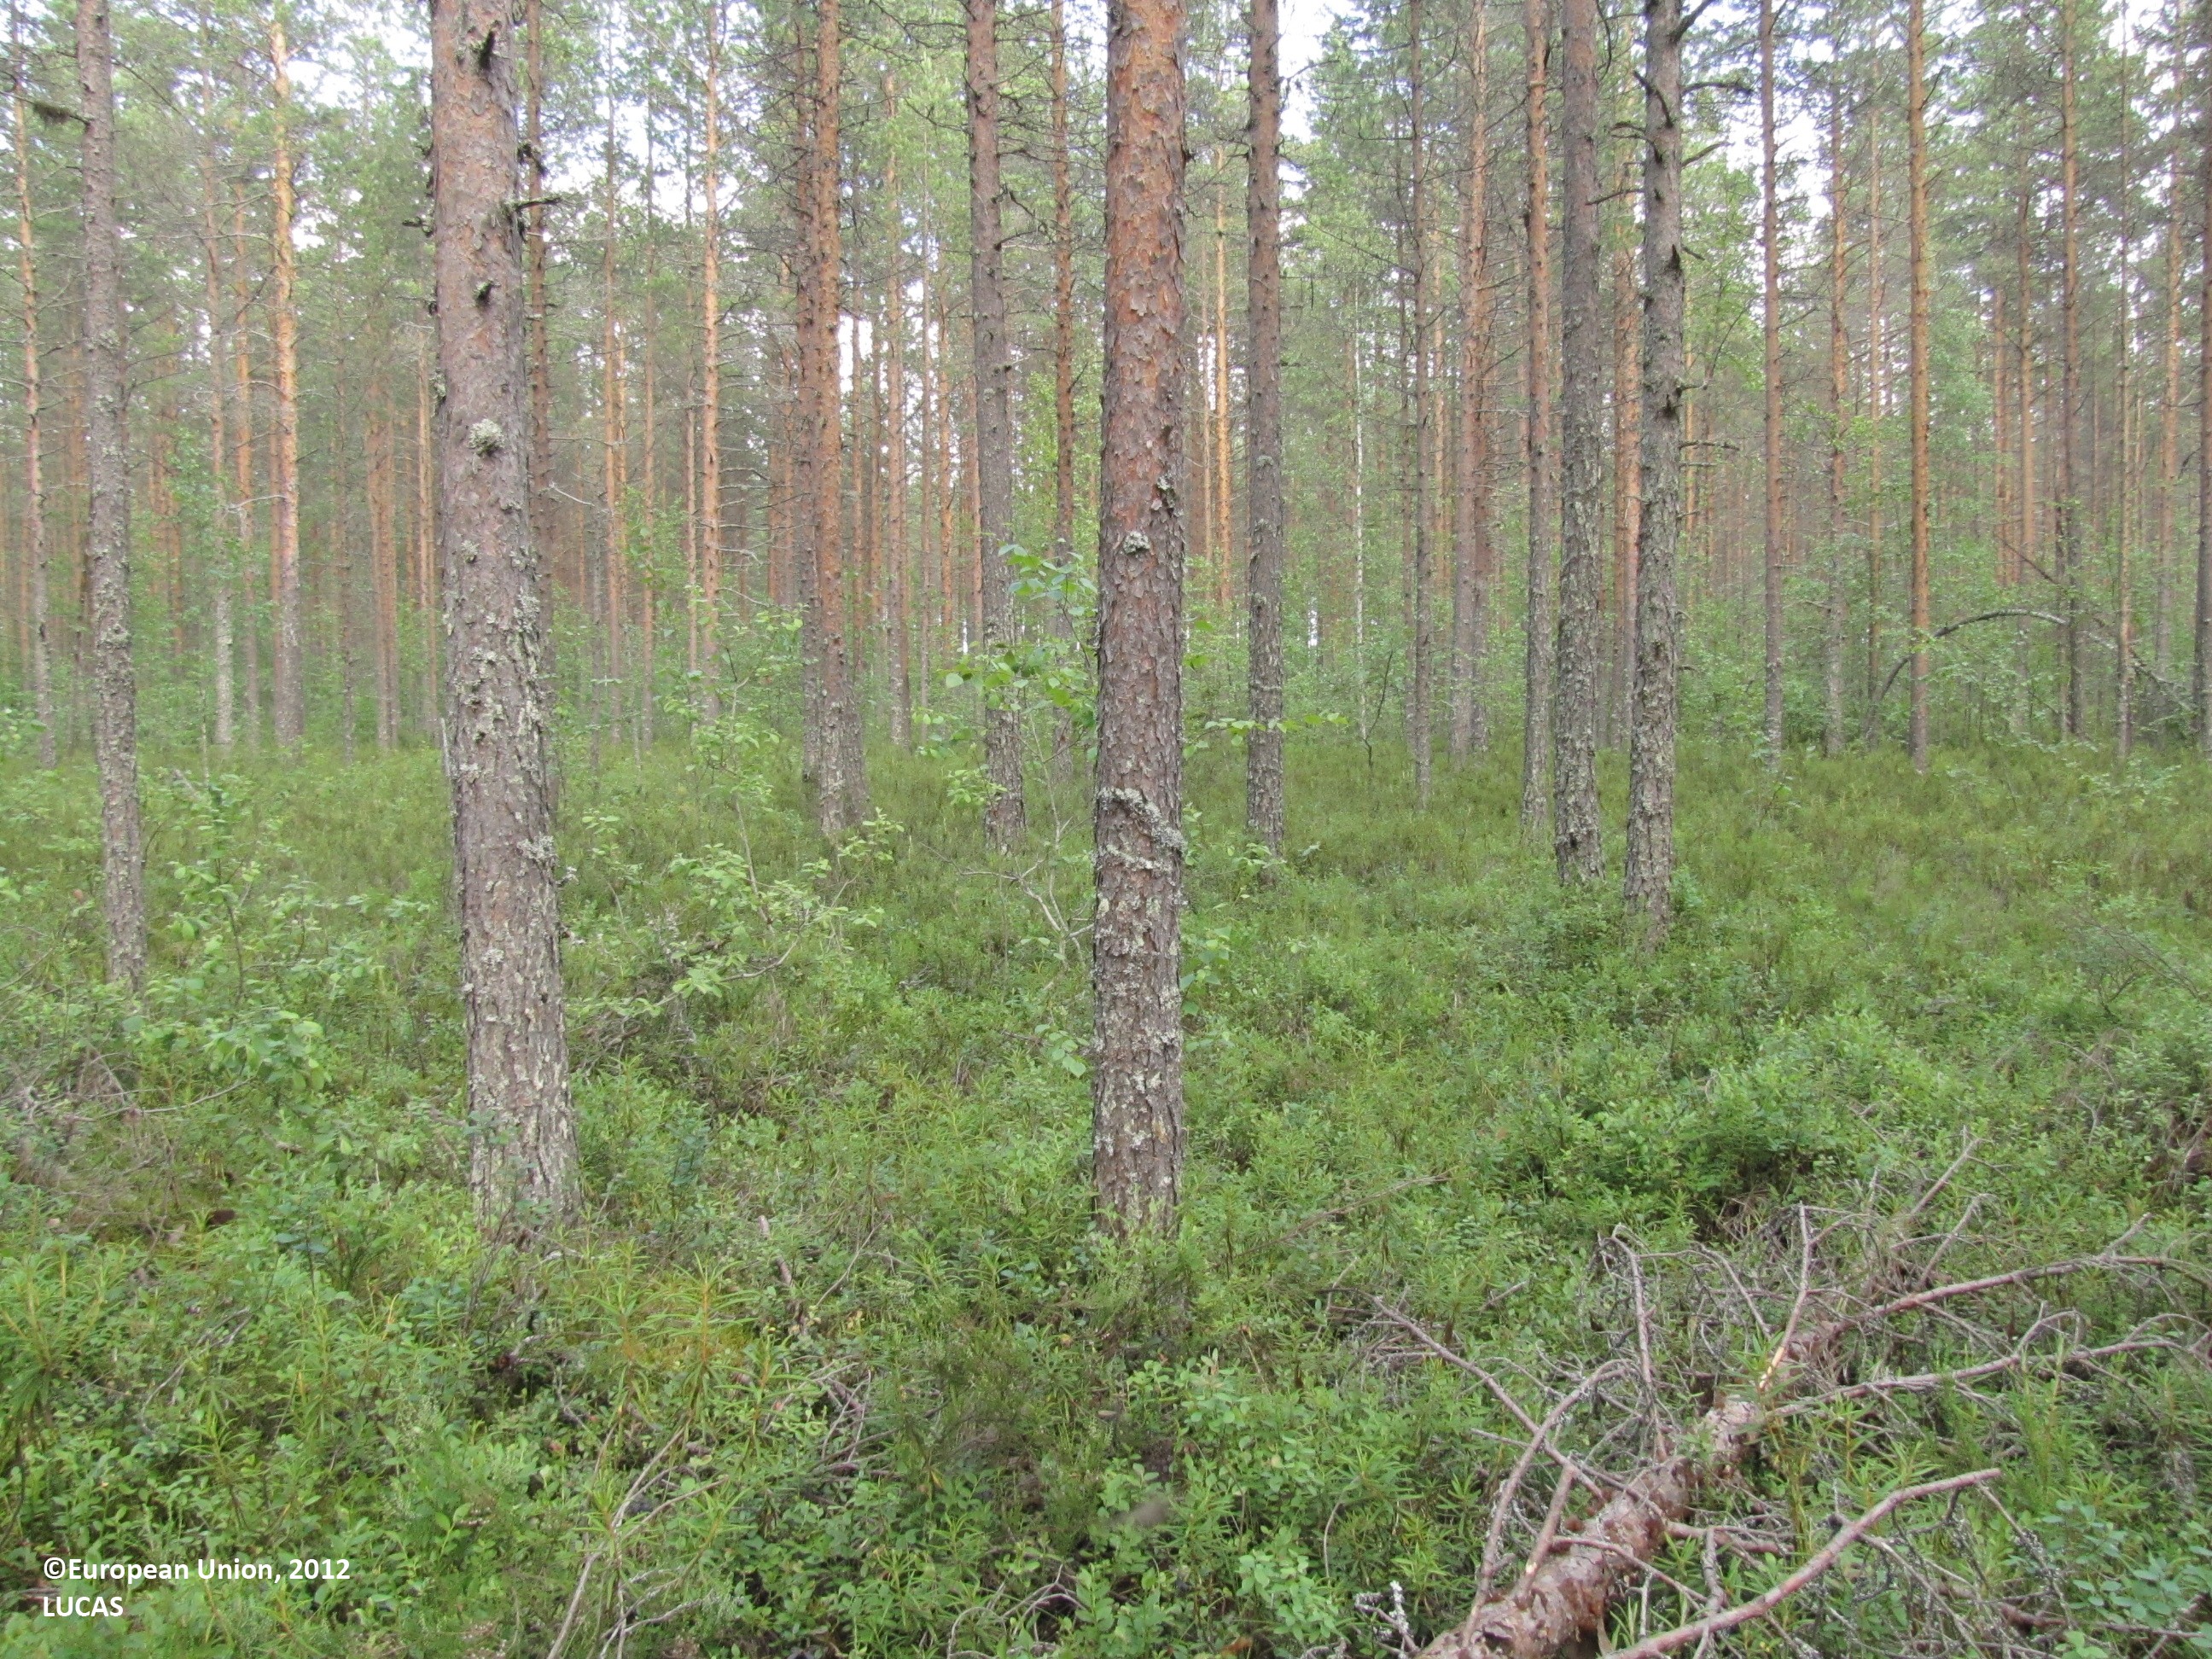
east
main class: Woodland
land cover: Pine dominated coniferous woodland
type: mire and swamp forests
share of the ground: 50 - 75 %
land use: Forestry
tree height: > 5 m
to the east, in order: Pine dominated coniferous woodland; Ditches and canals; Pine dominated coniferous woodland; Ditches and canals; Pine dominated coniferous woodland; Ditches and canals; Pine dominated coniferous woodland; Ditches and canals; Pine dominated coniferous woodland; Ditches and canals; Pine dominated coniferous woodland; Ditches and canals; Pine dominated coniferous woodland
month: July
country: FI
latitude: 62.3672
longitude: 23.5044
